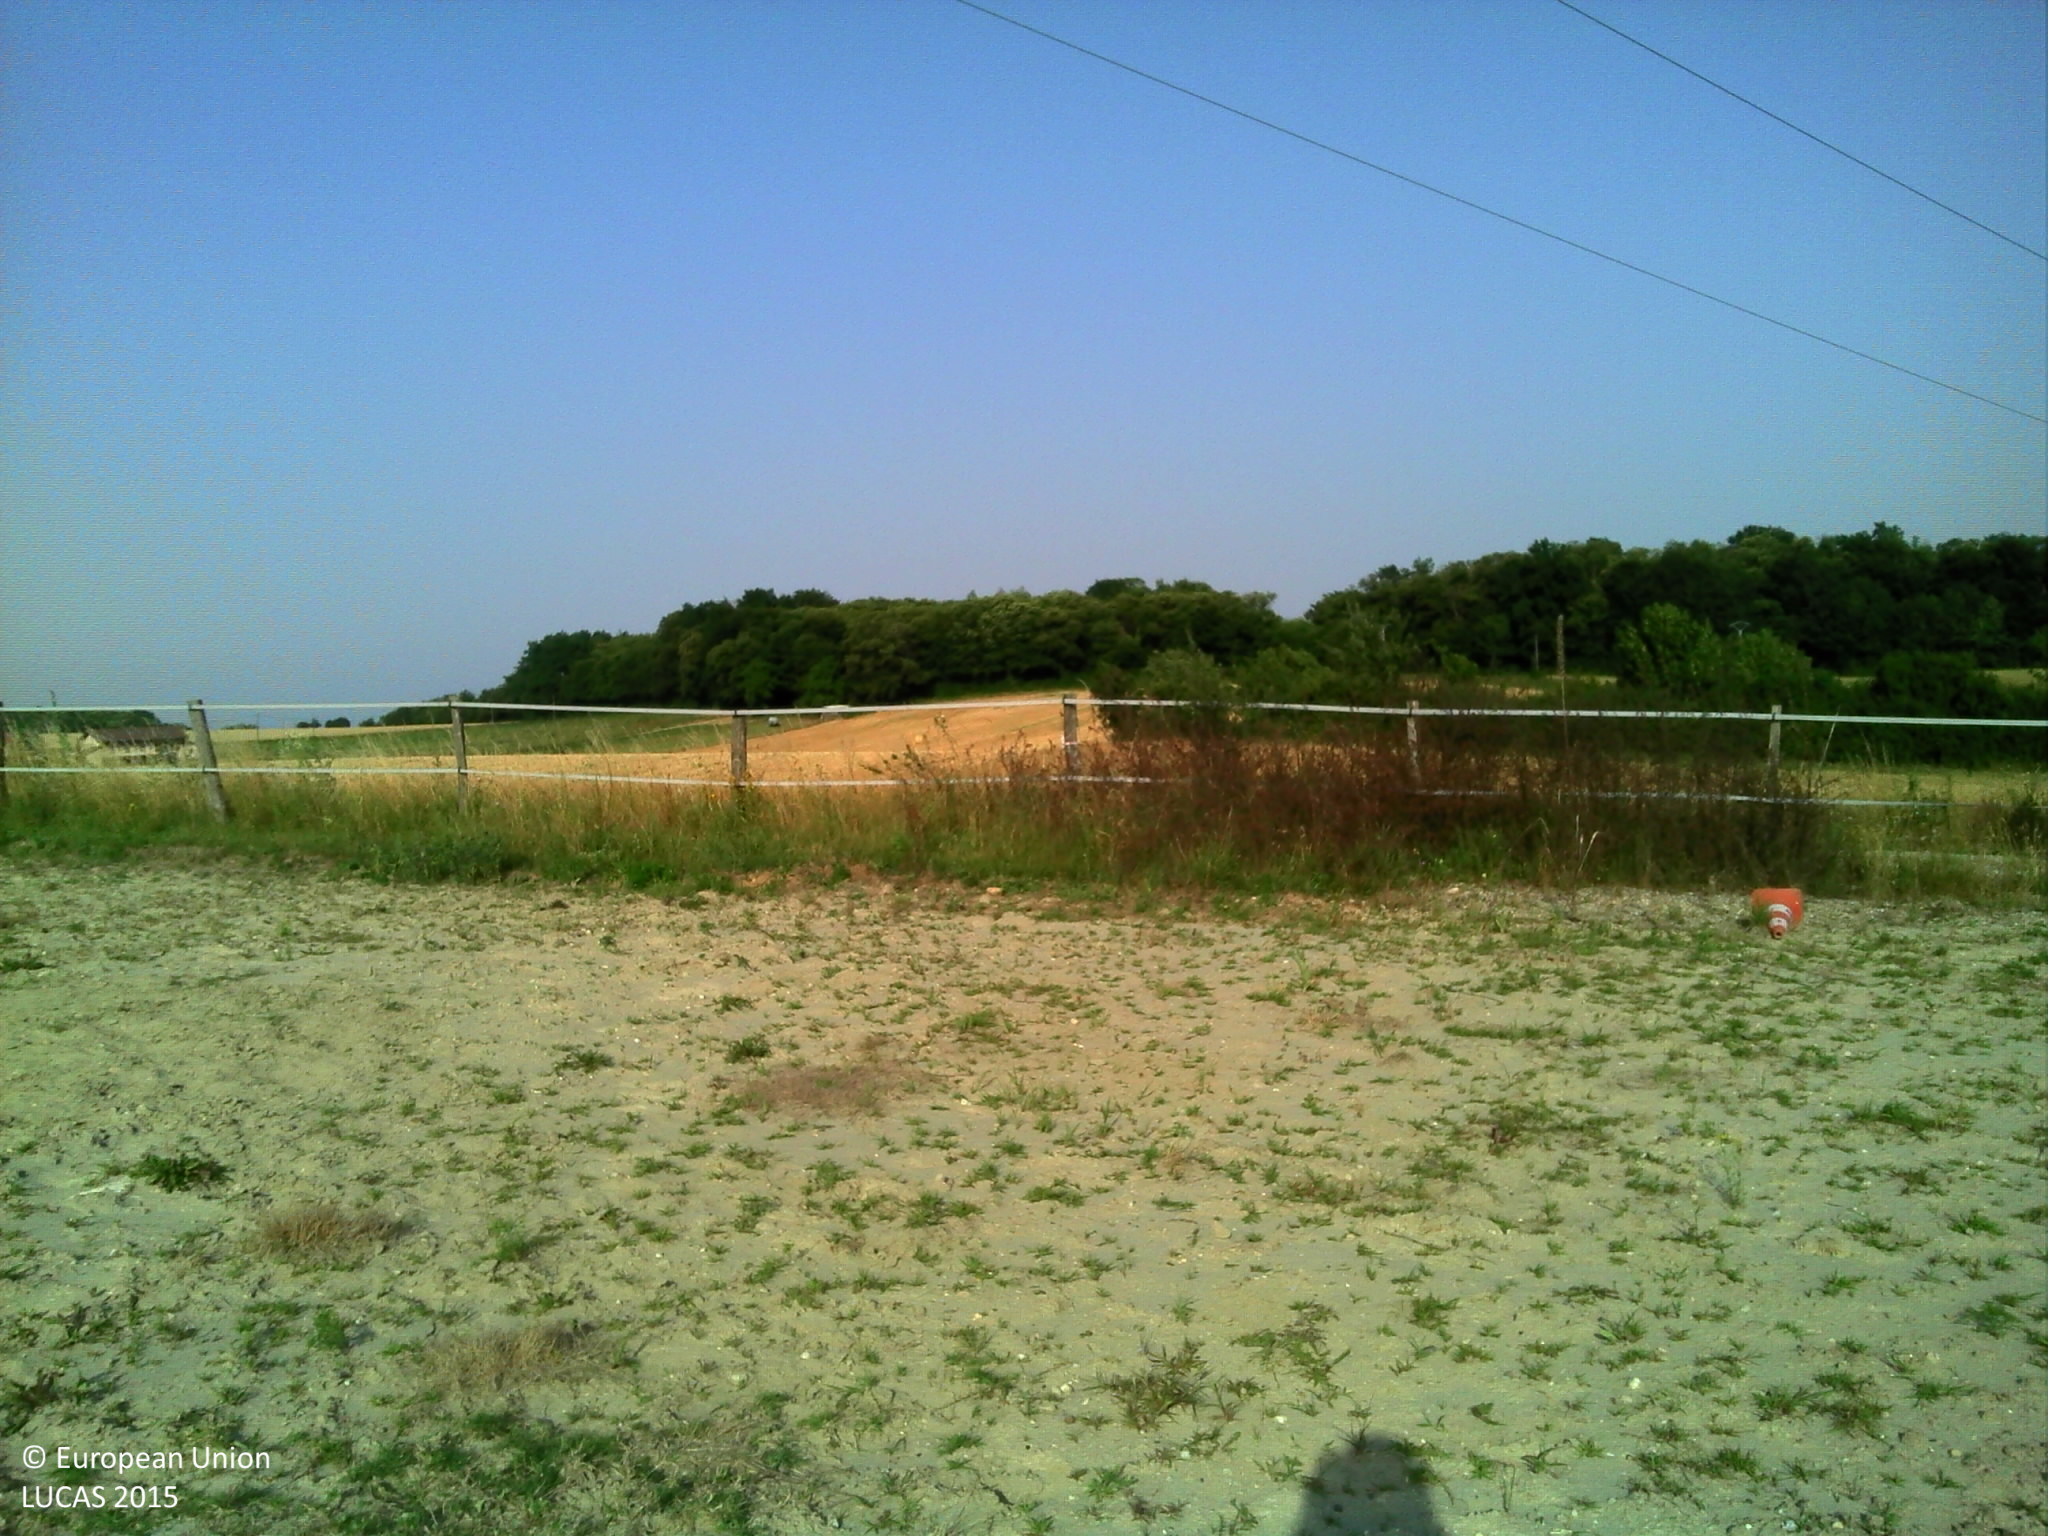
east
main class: Grassland
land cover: Grassland without tree/shrub cover
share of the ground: > 75 %
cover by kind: unconsolidated bare surface 85 %, herbaceous plants 15 %
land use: Agriculture (excluding fallow land and kitchen gardens)
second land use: Sport
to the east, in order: Grassland without tree/shrub cover; Fences; Tracks; Electric lines; Grass margins; Durum wheat
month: July
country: FR
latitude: 45.5577
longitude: 5.2003
